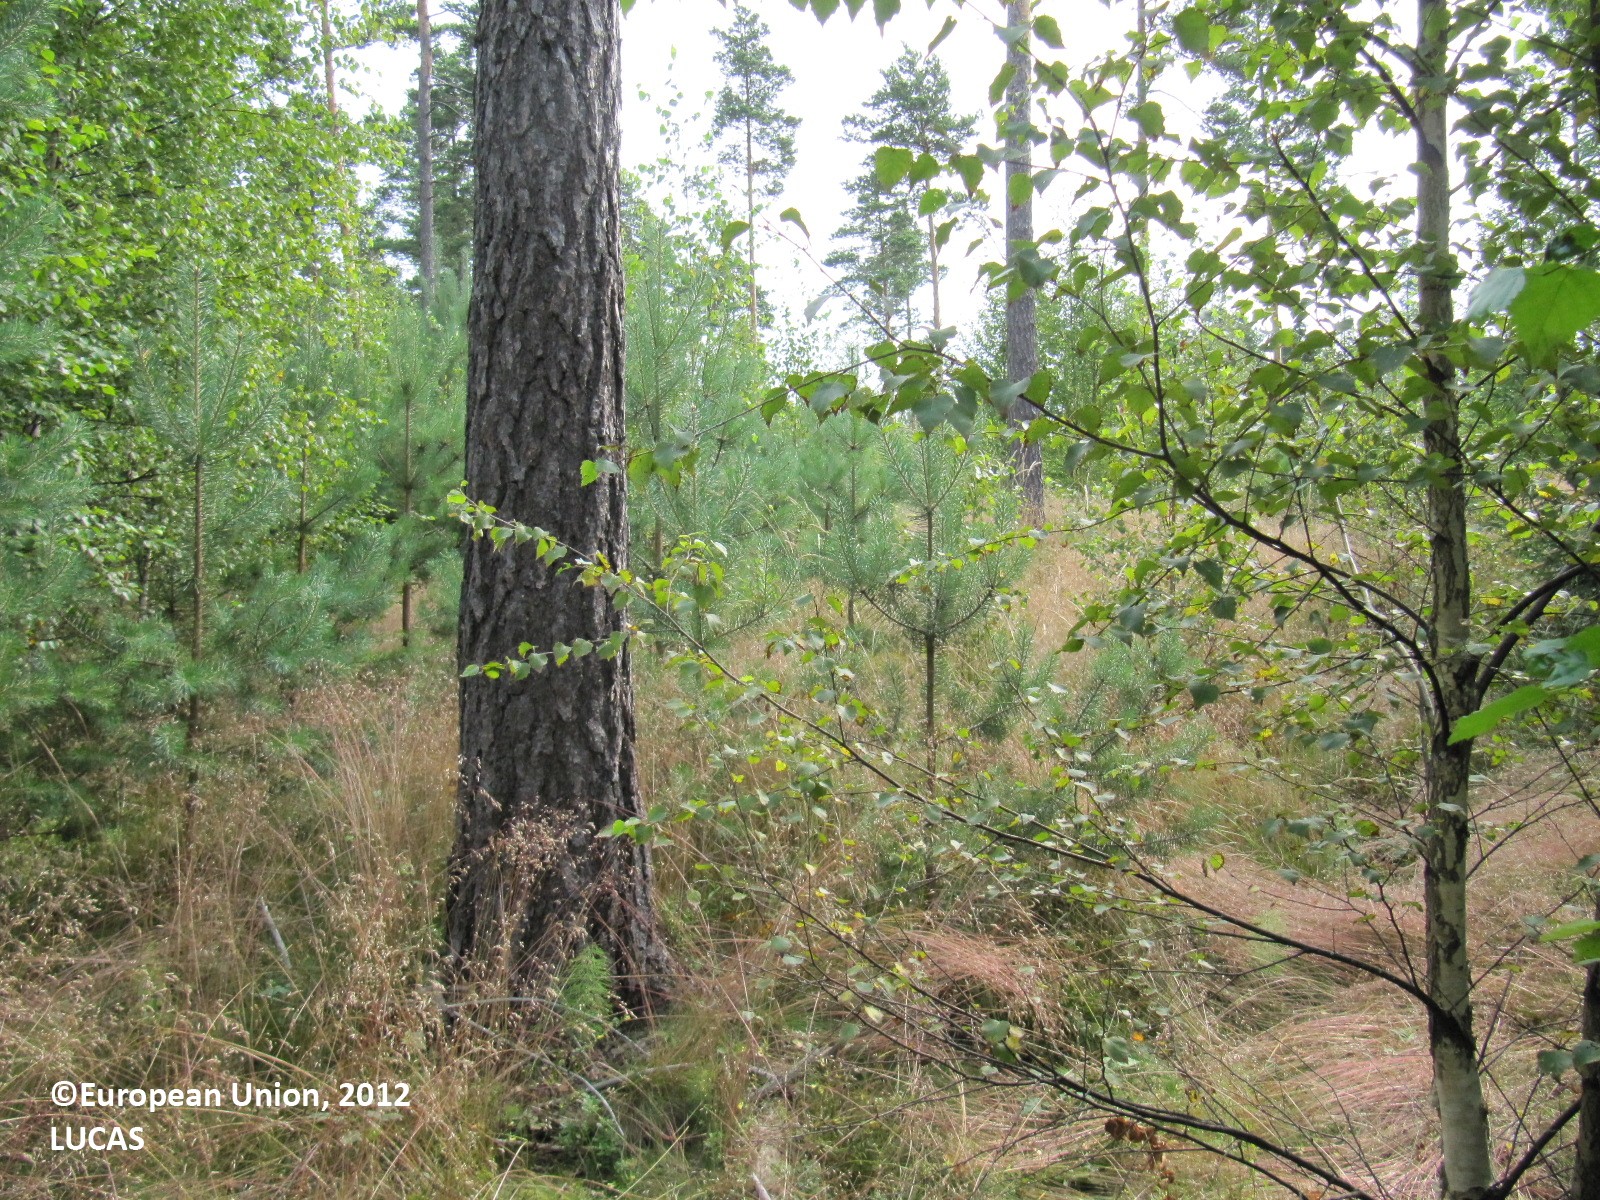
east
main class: Woodland
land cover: Other mixed woodland
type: boreal forest
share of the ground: 50 - 75 %
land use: Forestry
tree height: < 5 m
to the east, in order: Other mixed woodland; Spruce dominated mixed woodland; Artificial constructions in urban areas; Other mixed woodland
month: August
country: FI
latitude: 60.4684
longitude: 23.2320
